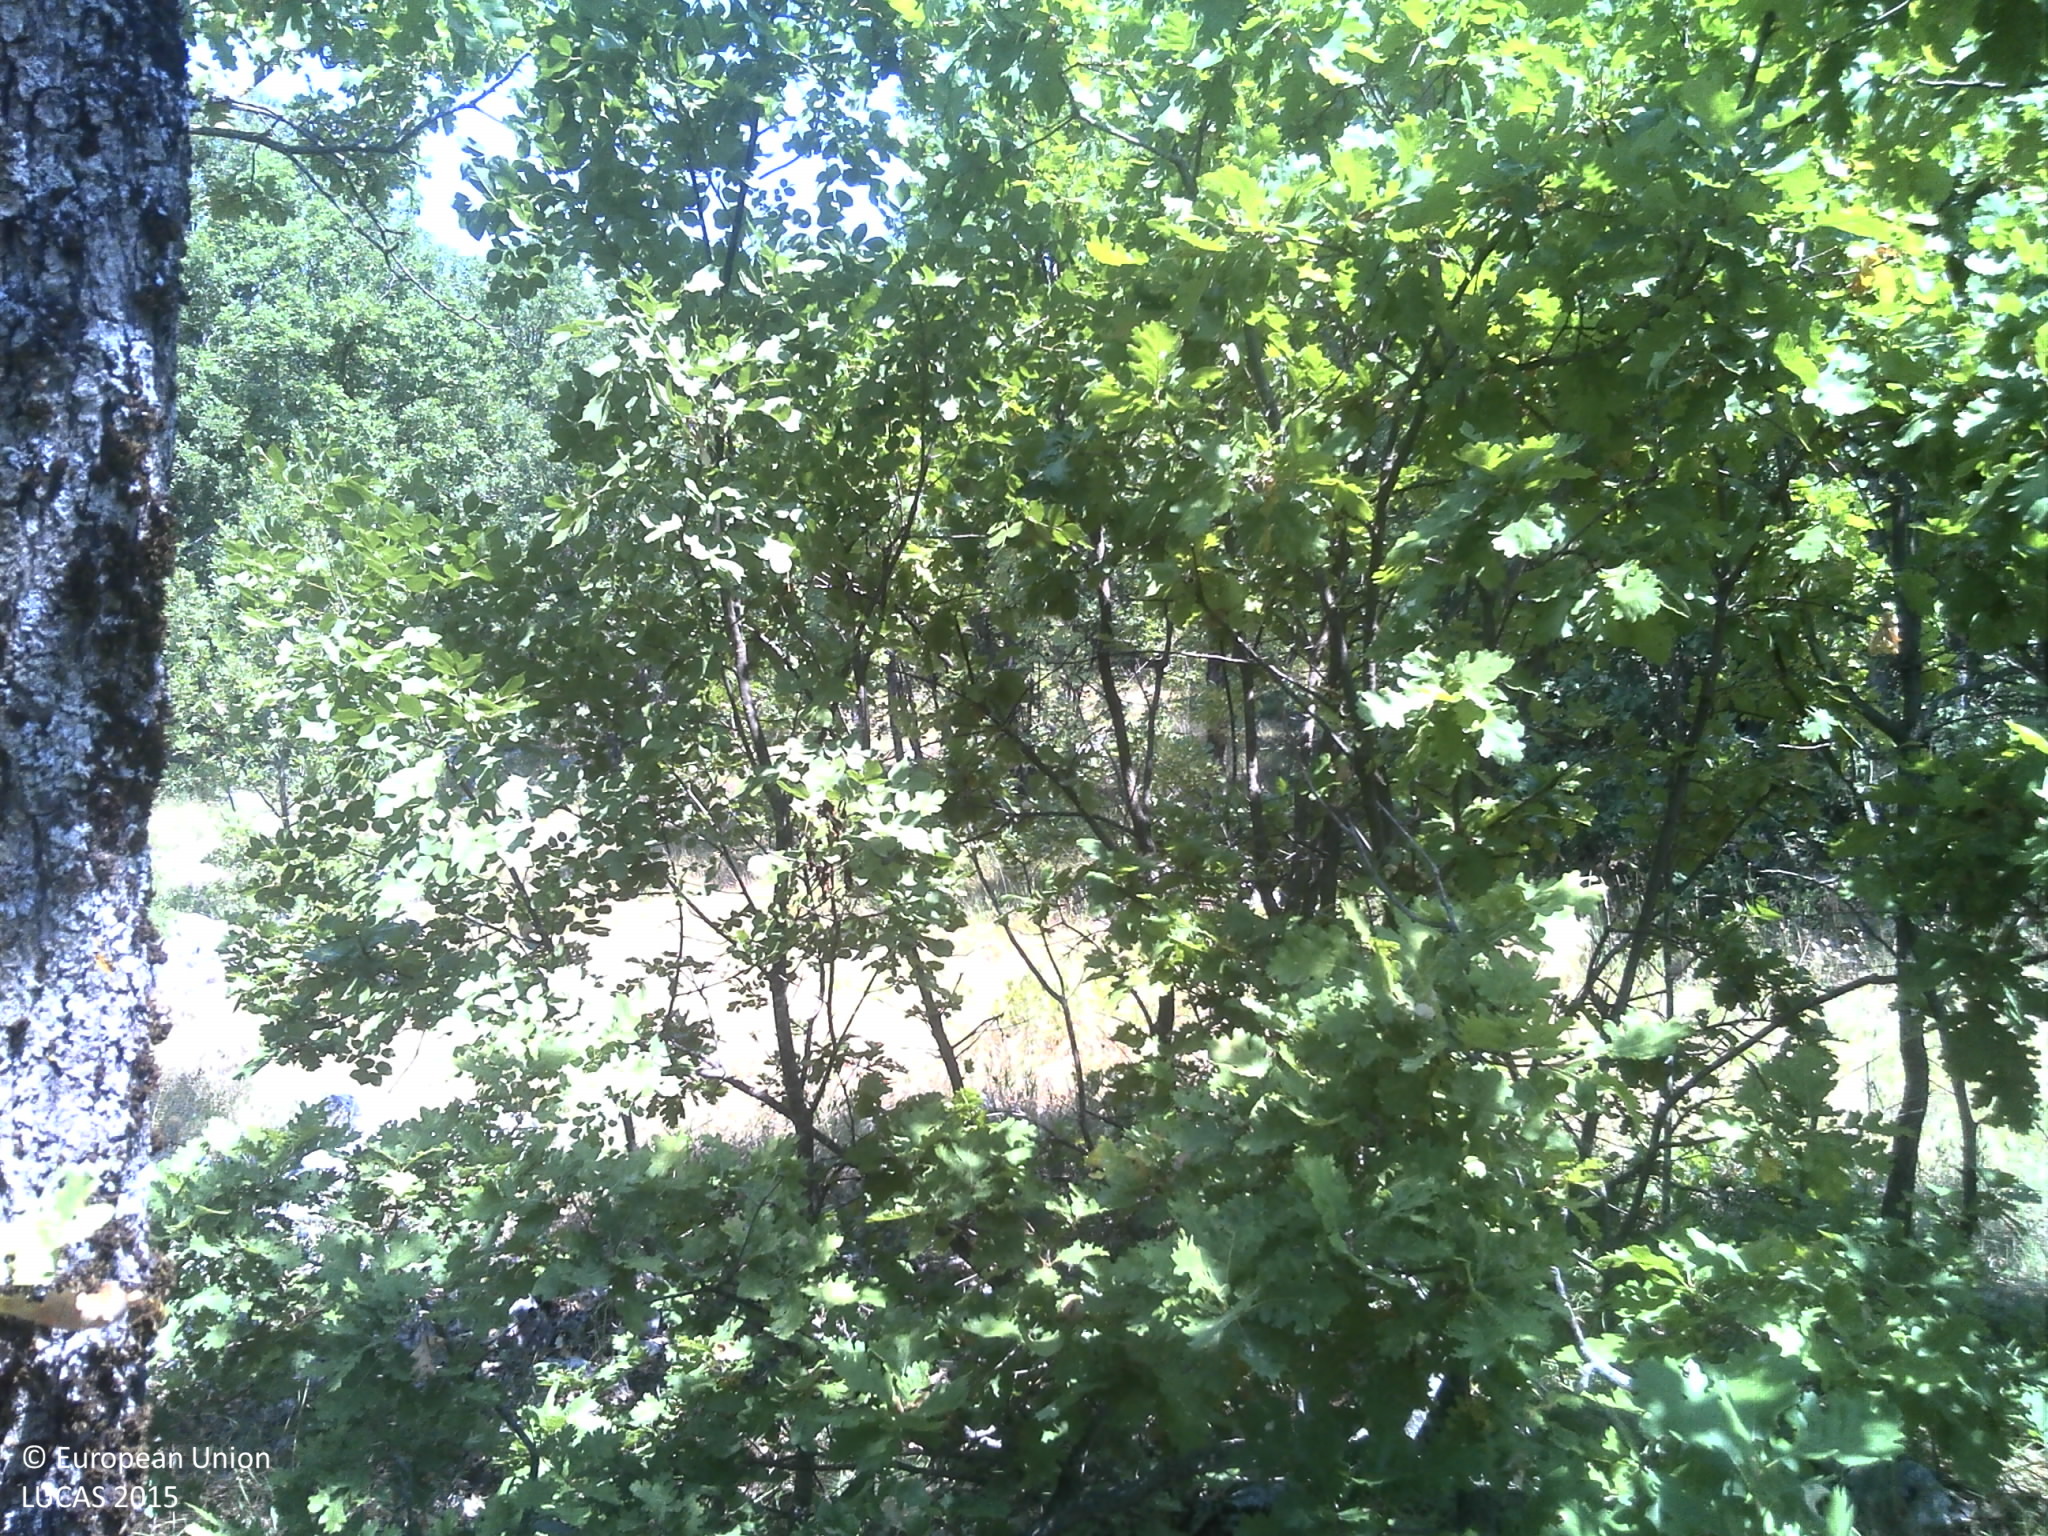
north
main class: Woodland
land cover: Broadleaved woodland
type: thermophilous deciduous forest
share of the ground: > 75 %
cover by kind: broadleaved forest trees 70 %, shrubs 10 %, herbaceous plants 5 %, lichens and mosses 5 %, consolidated bare surface 5 %, unconsolidated bare surface 5 %
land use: Semi-natural and natural areas not in use
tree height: > 5 m
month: July
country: HR
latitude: 43.4632
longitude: 17.2474
